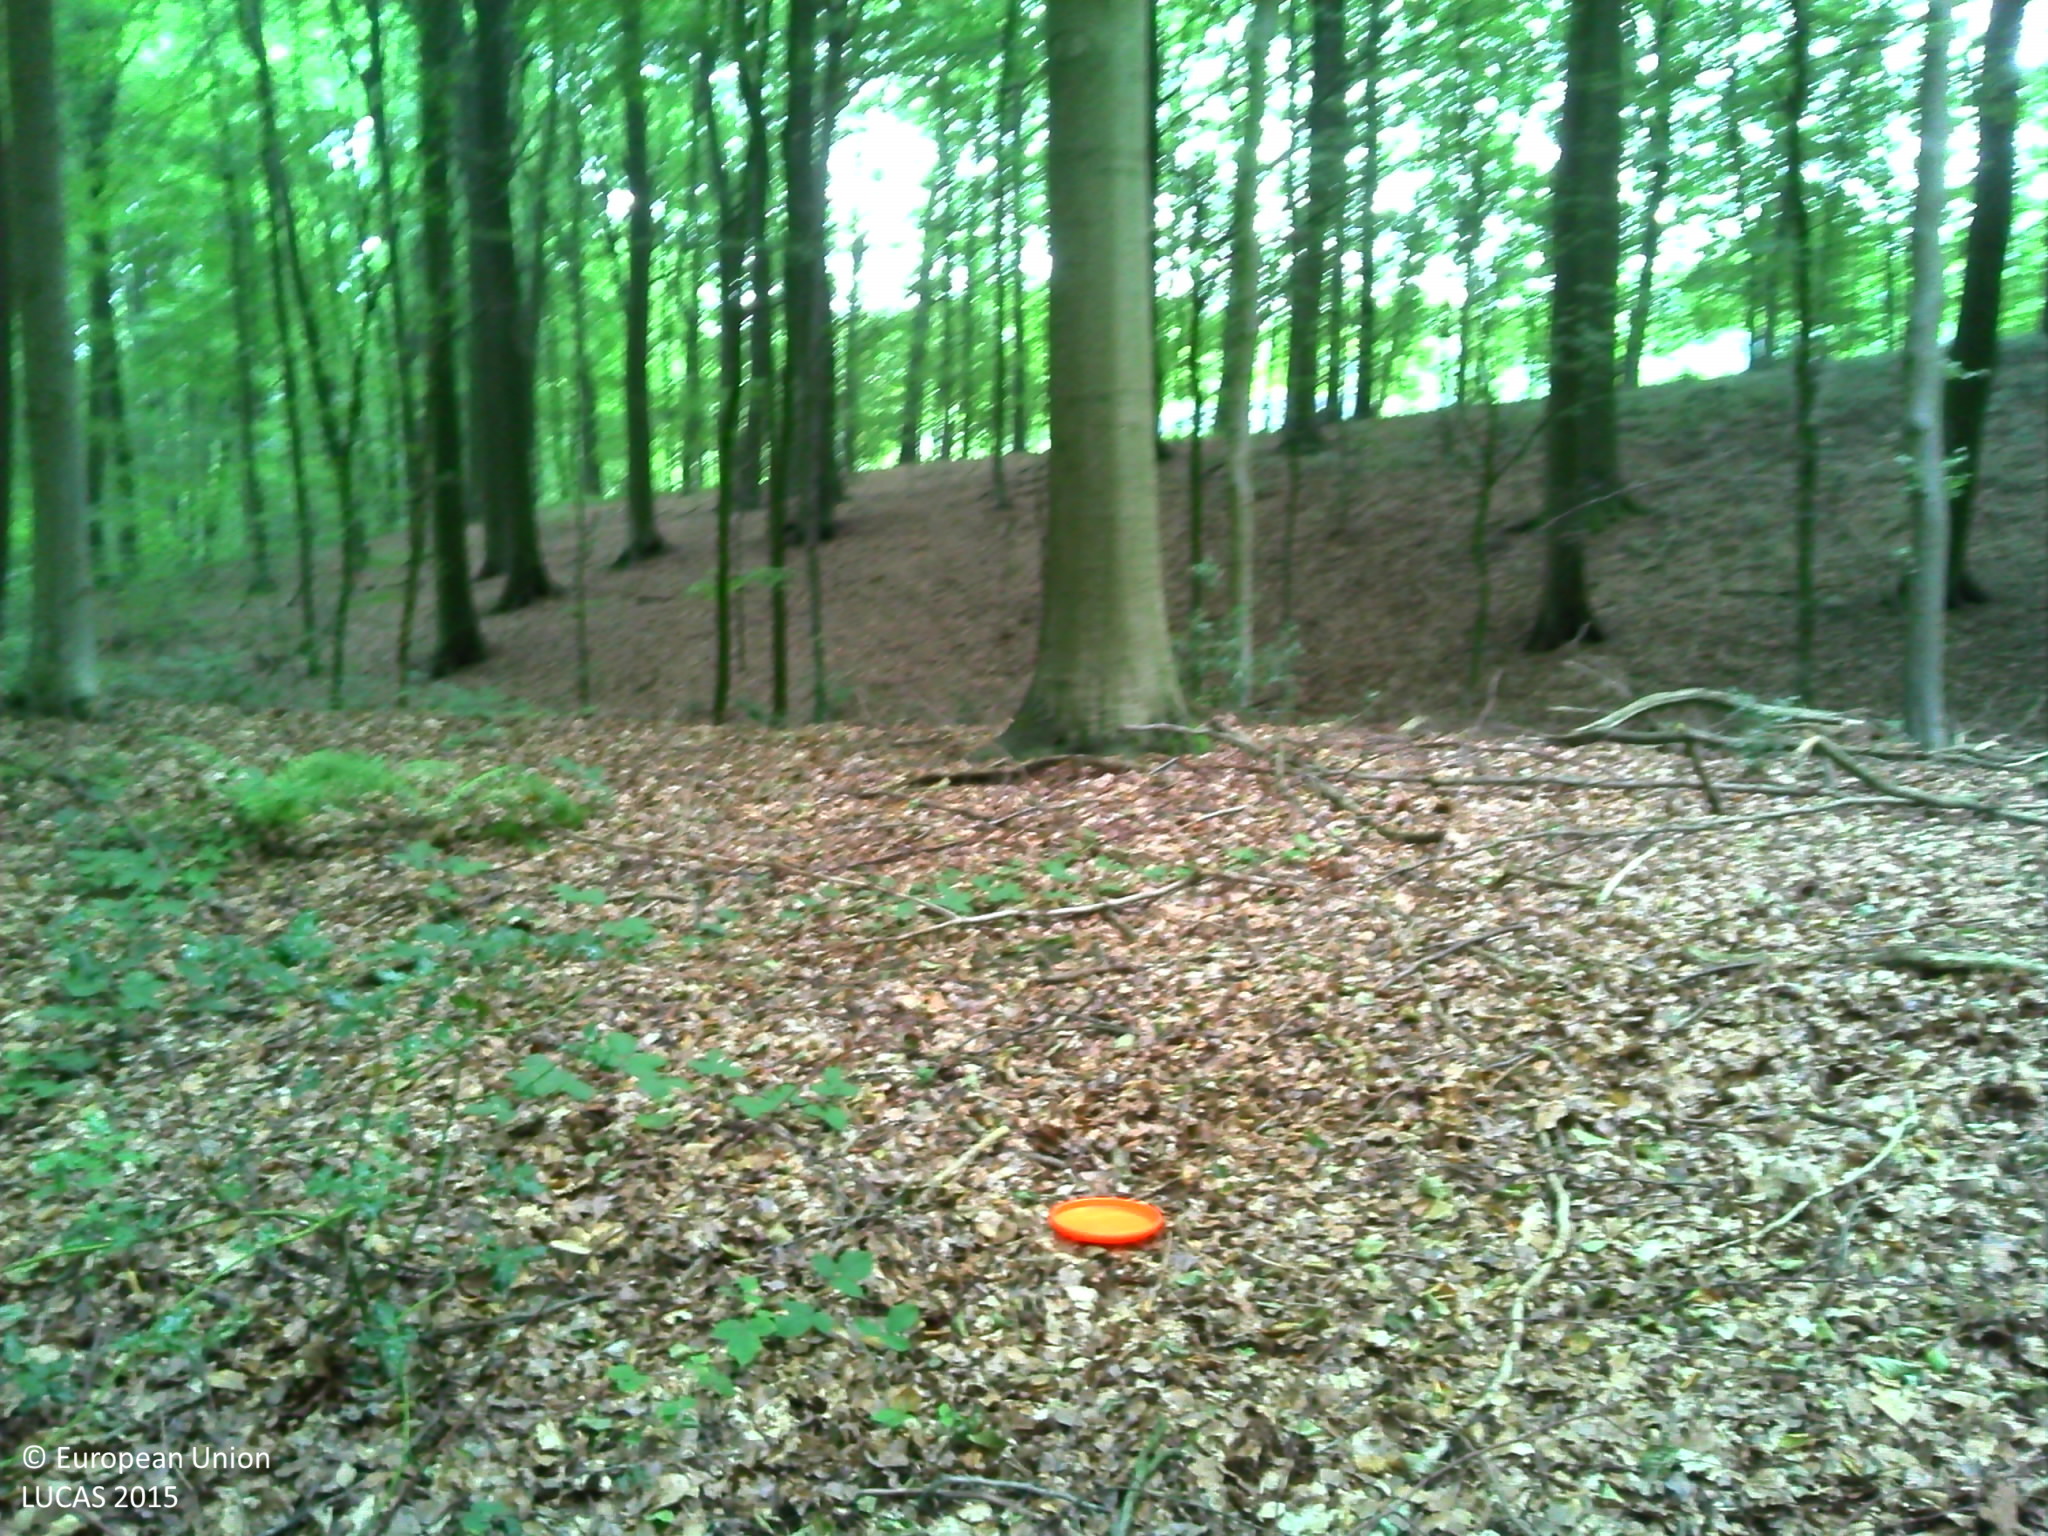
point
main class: Woodland
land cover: Broadleaved woodland
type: beech forest
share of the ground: > 75 %
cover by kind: broadleaved forest trees 90 %, shrubs 5 %, herbaceous plants 5 %
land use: Forestry
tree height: > 5 m
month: August
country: BE
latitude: 50.7098
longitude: 3.6343
